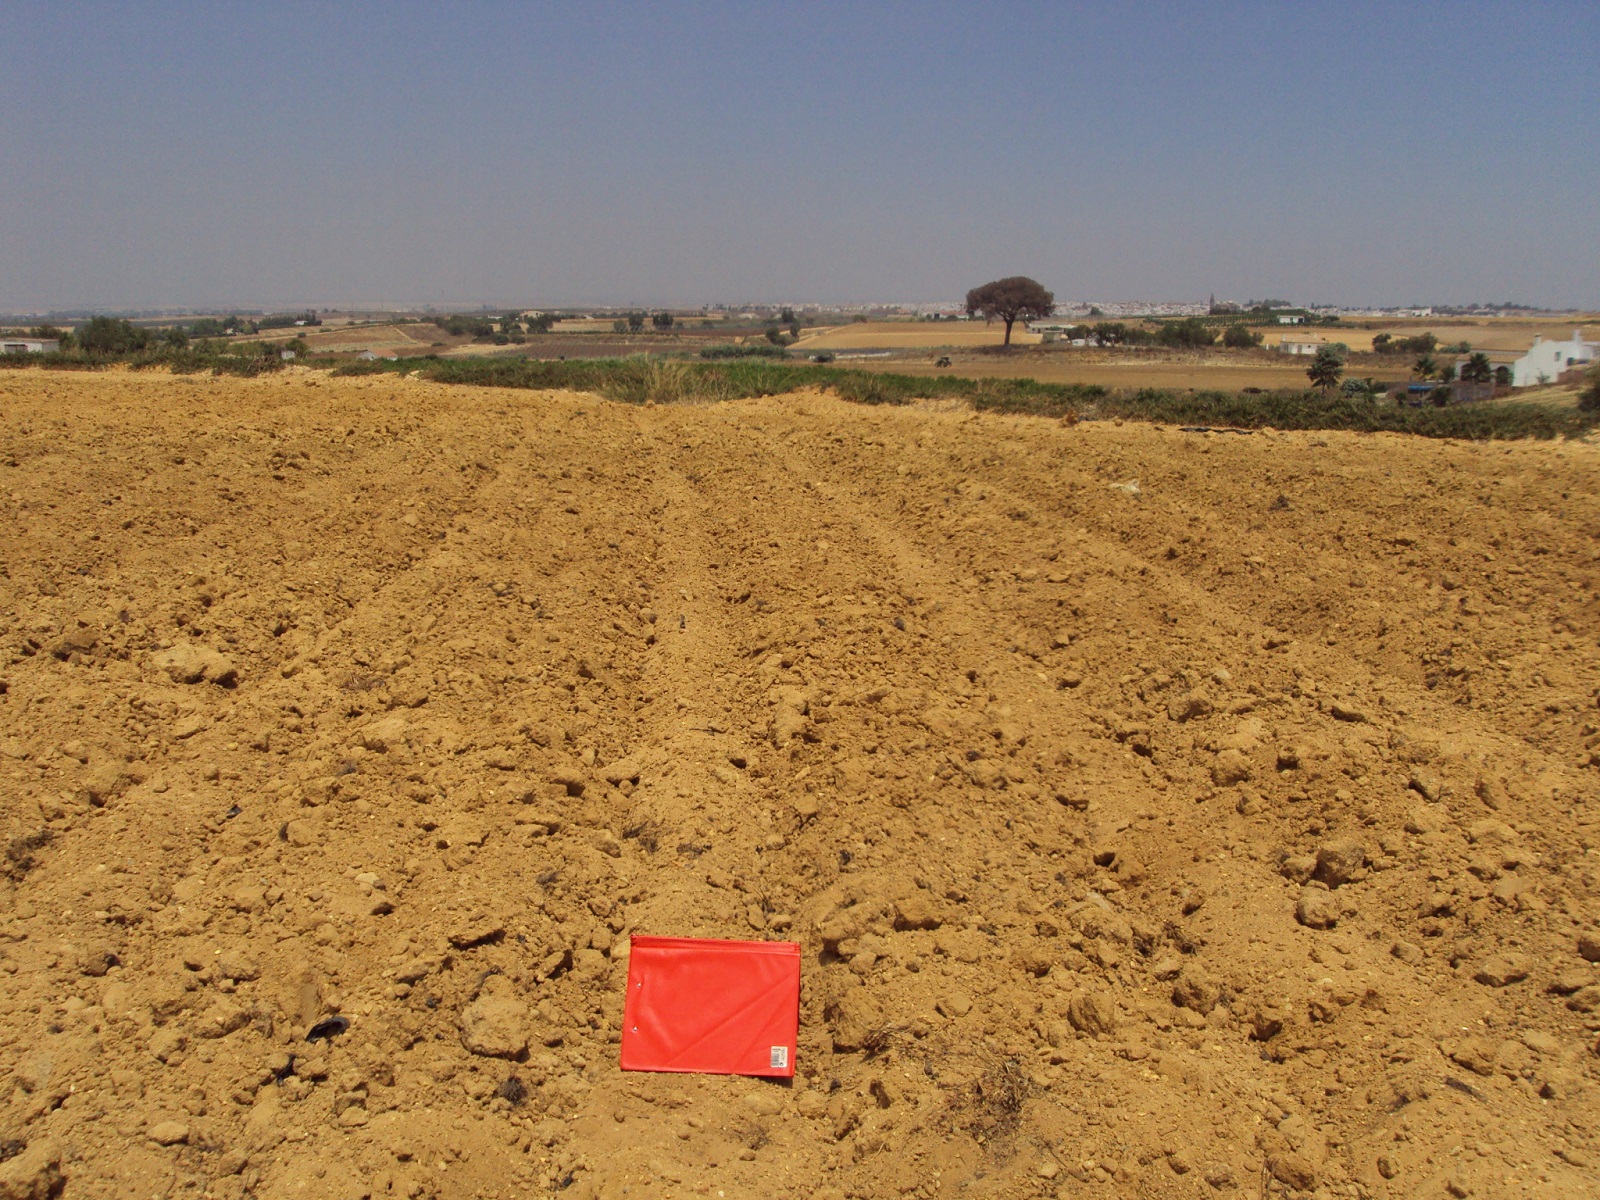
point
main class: Cropland
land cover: Strawberries
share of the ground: > 75 %
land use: Agriculture (excluding fallow land and kitchen gardens)
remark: Harvested field
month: June
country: ES
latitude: 37.2490
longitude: -6.8454
